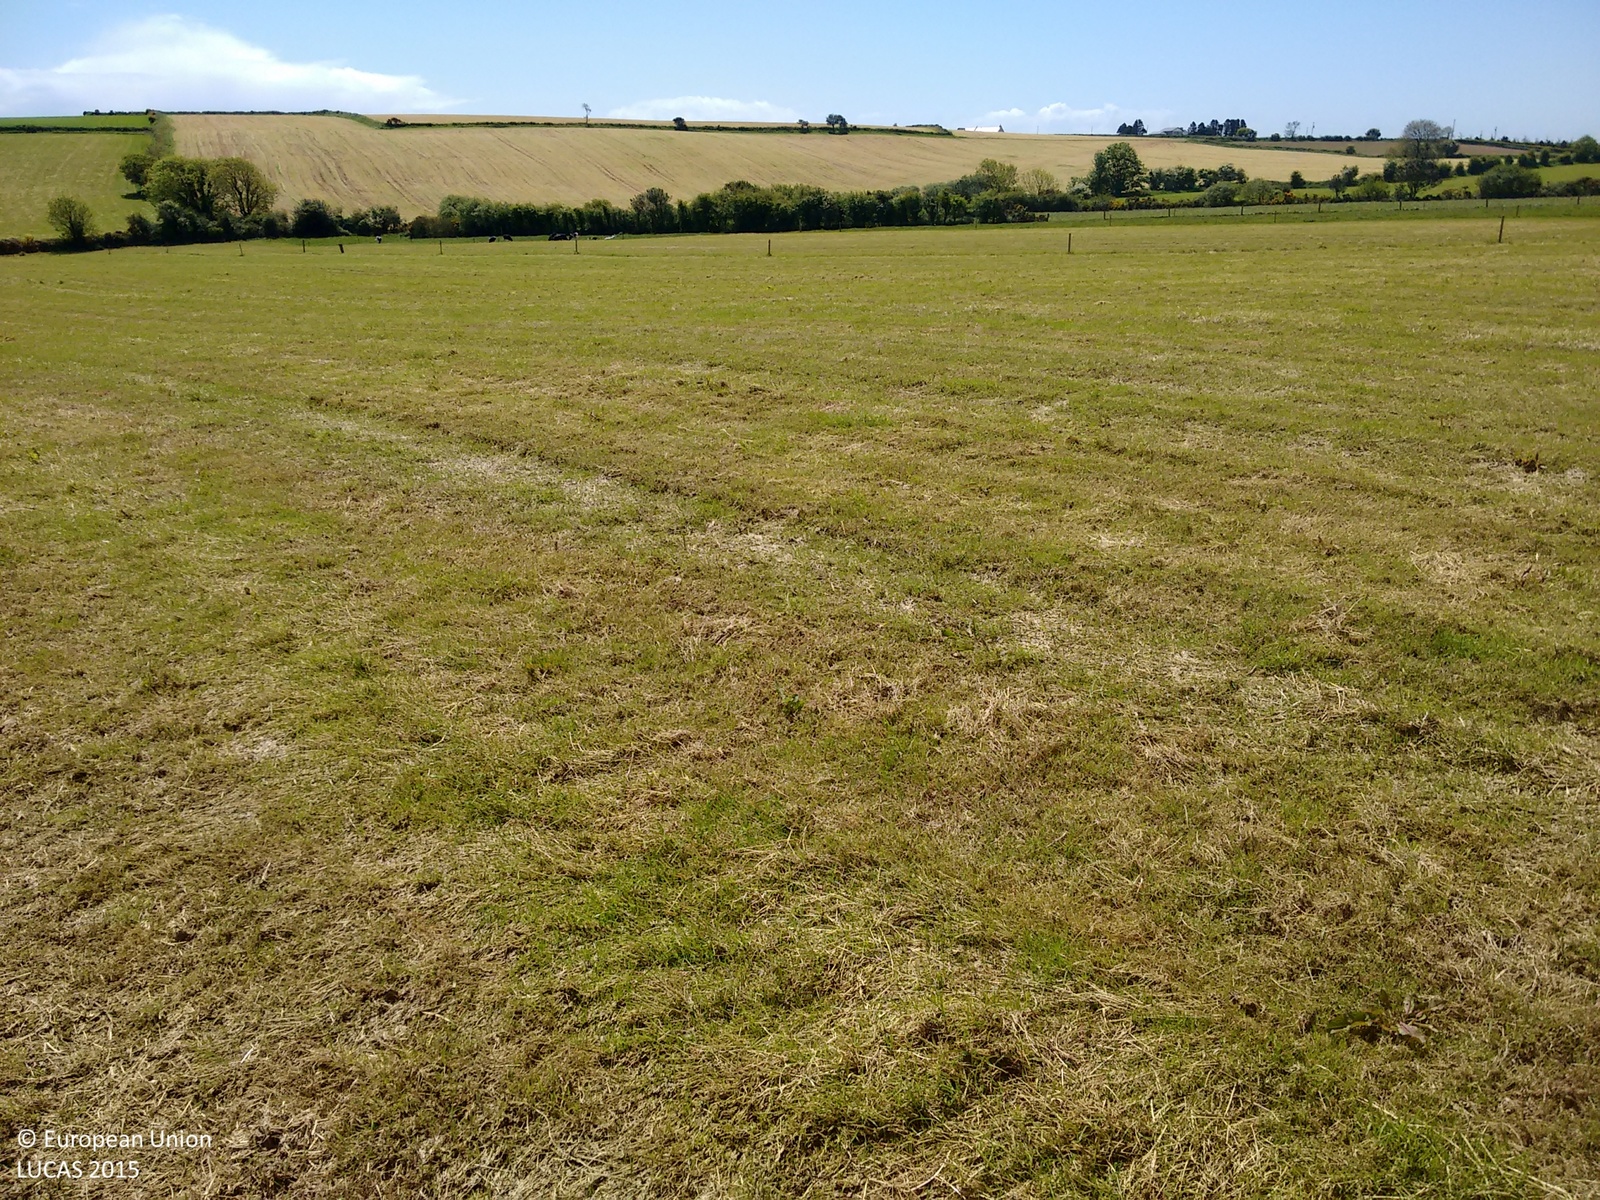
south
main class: Grassland
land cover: Grassland without tree/shrub cover
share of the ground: > 75 %
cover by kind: herbaceous plants 80 %, unconsolidated bare surface 20 %
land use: Agriculture (excluding fallow land and kitchen gardens)
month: June
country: IE
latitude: 51.6673
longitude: -8.6937
